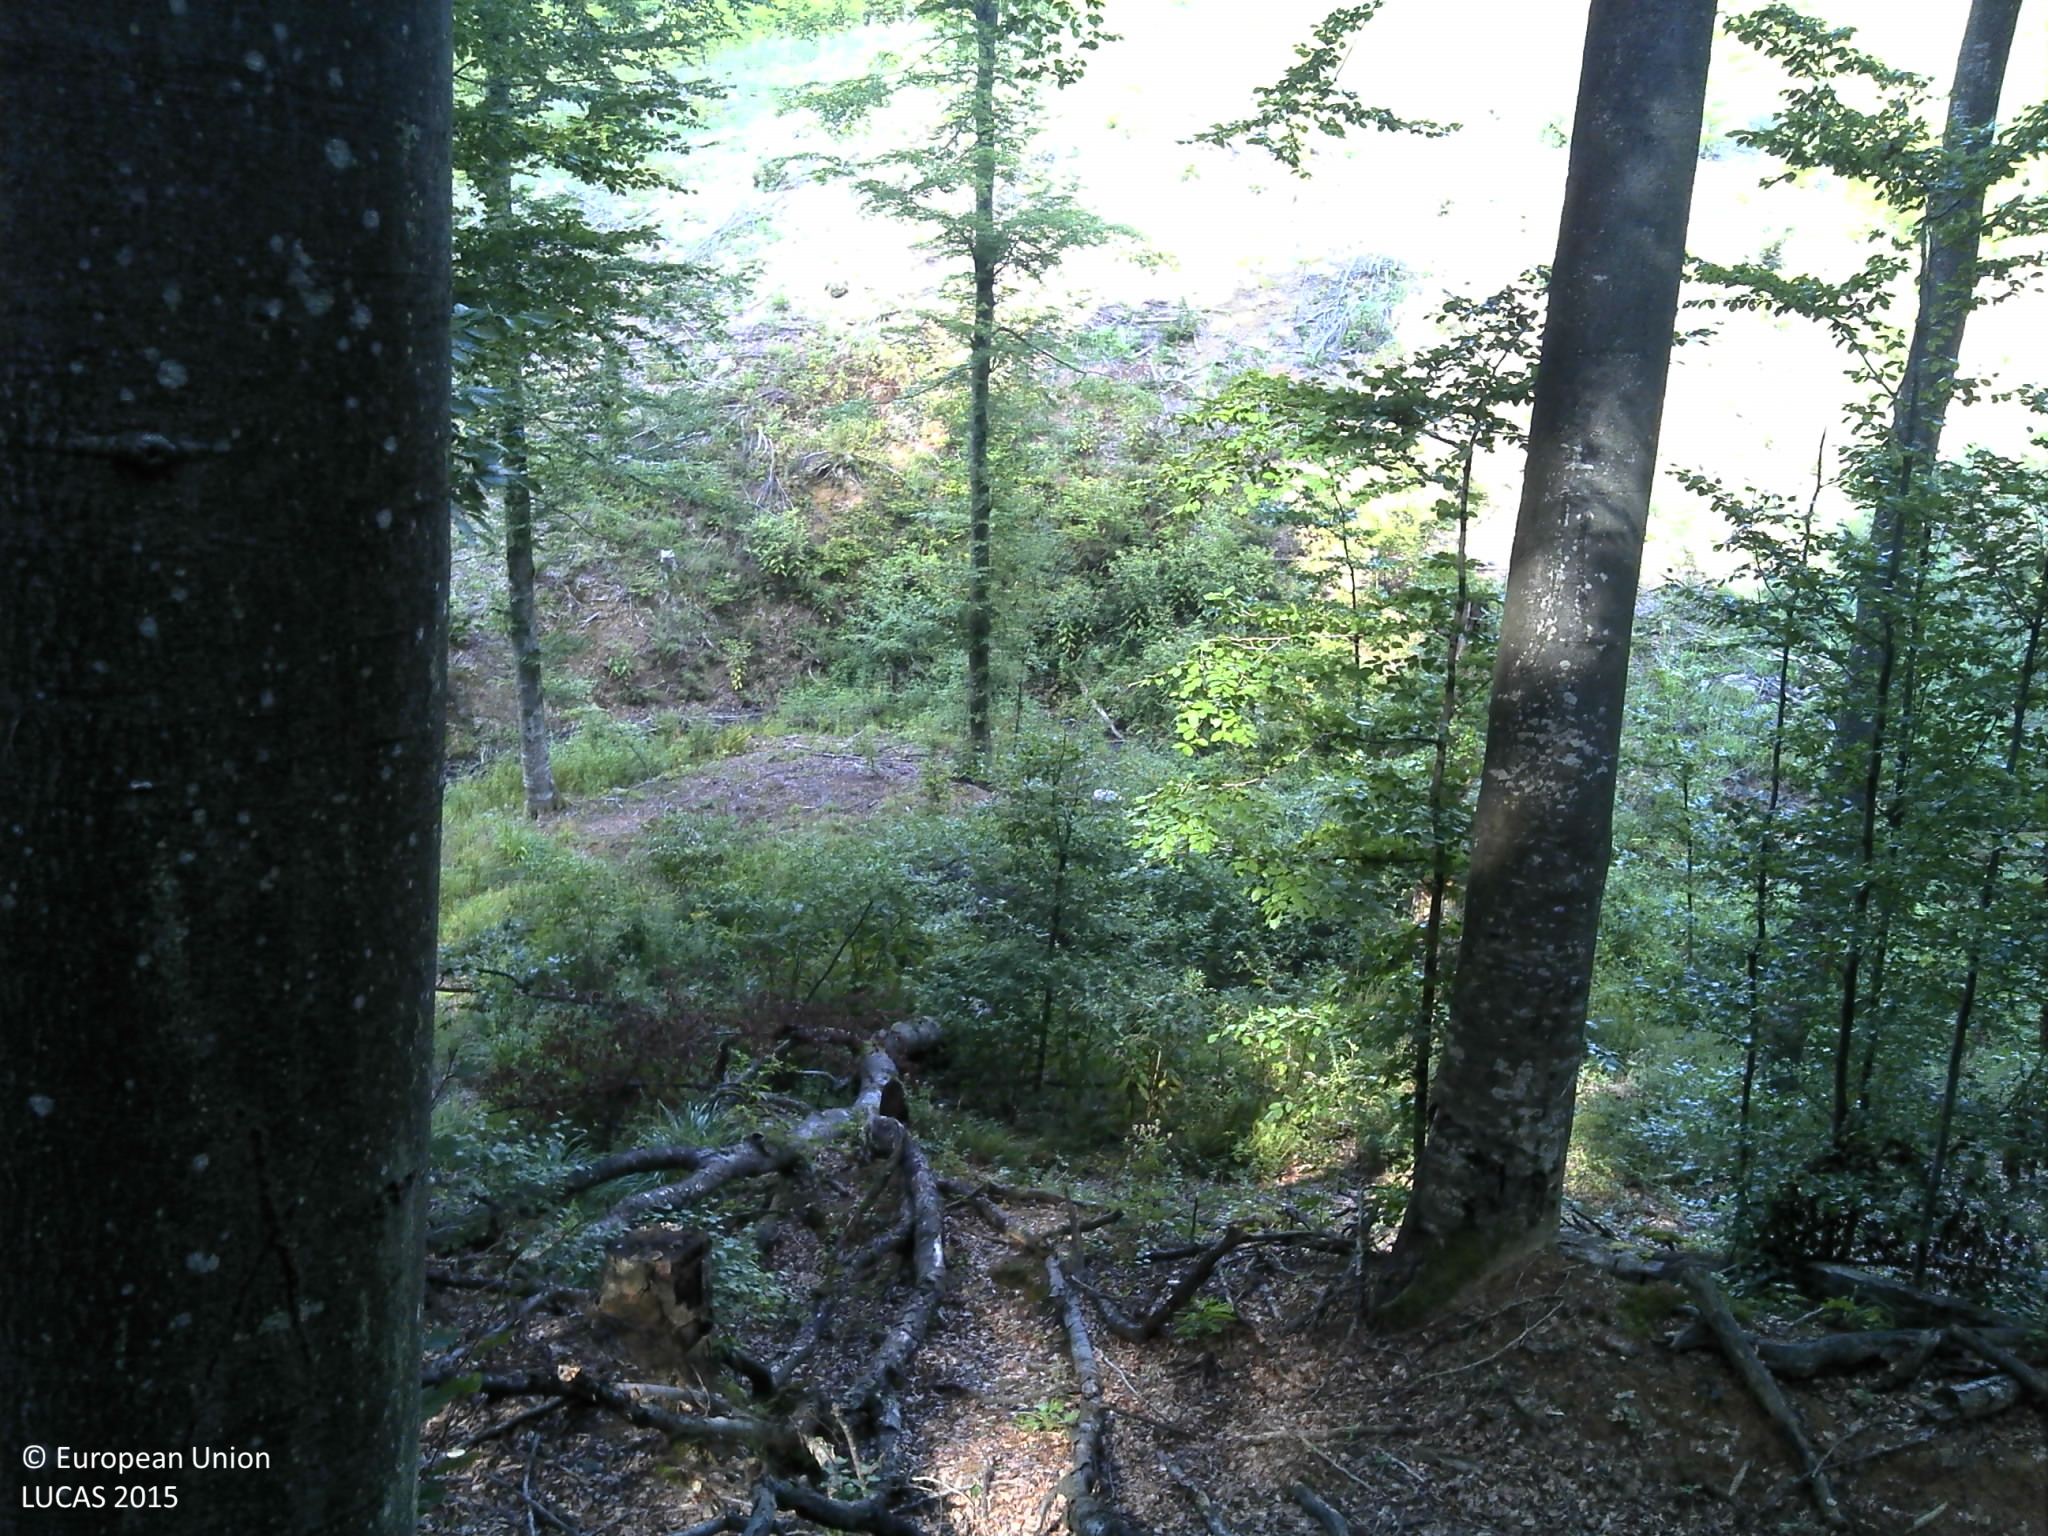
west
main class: Woodland
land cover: Broadleaved woodland
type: beech forest
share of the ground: > 75 %
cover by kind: broadleaved forest trees 100 %
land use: Forestry
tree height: > 5 m
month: August
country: HR
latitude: 45.2213
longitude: 16.0709
